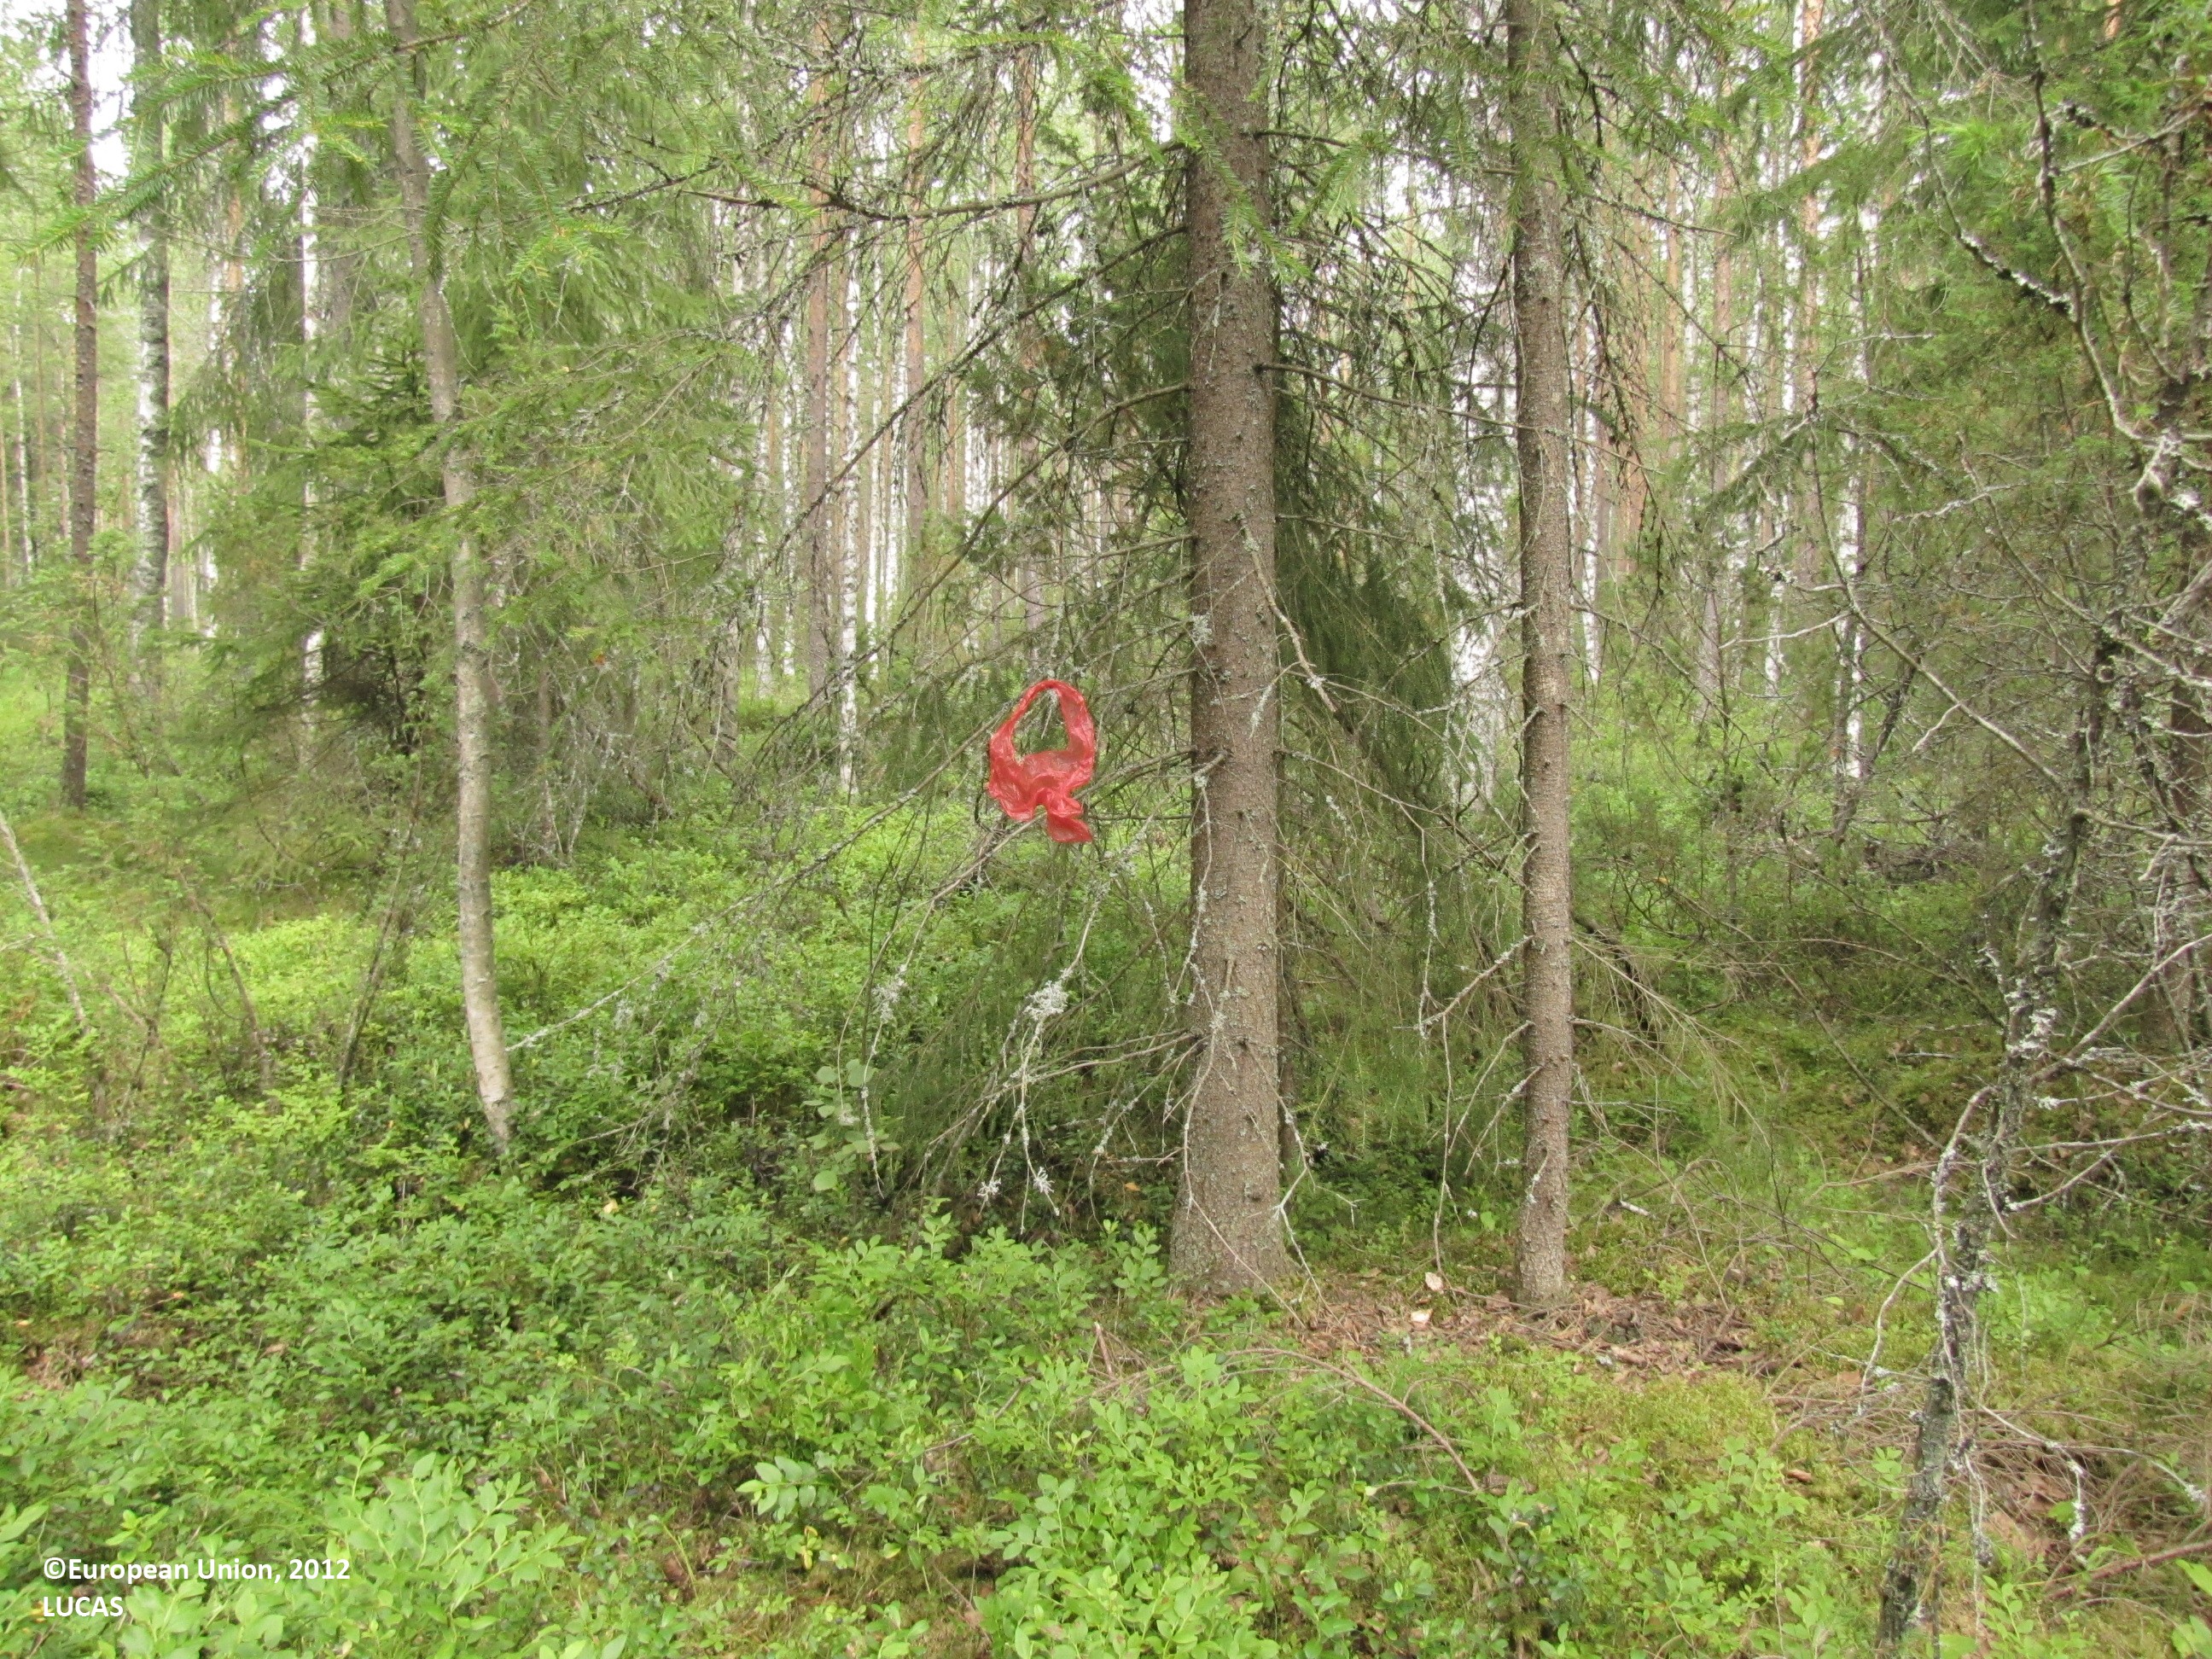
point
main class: Woodland
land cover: Other mixed woodland
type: boreal forest
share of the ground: > 75 %
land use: Forestry
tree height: > 5 m
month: July
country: FI
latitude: 62.6363
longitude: 22.9517
